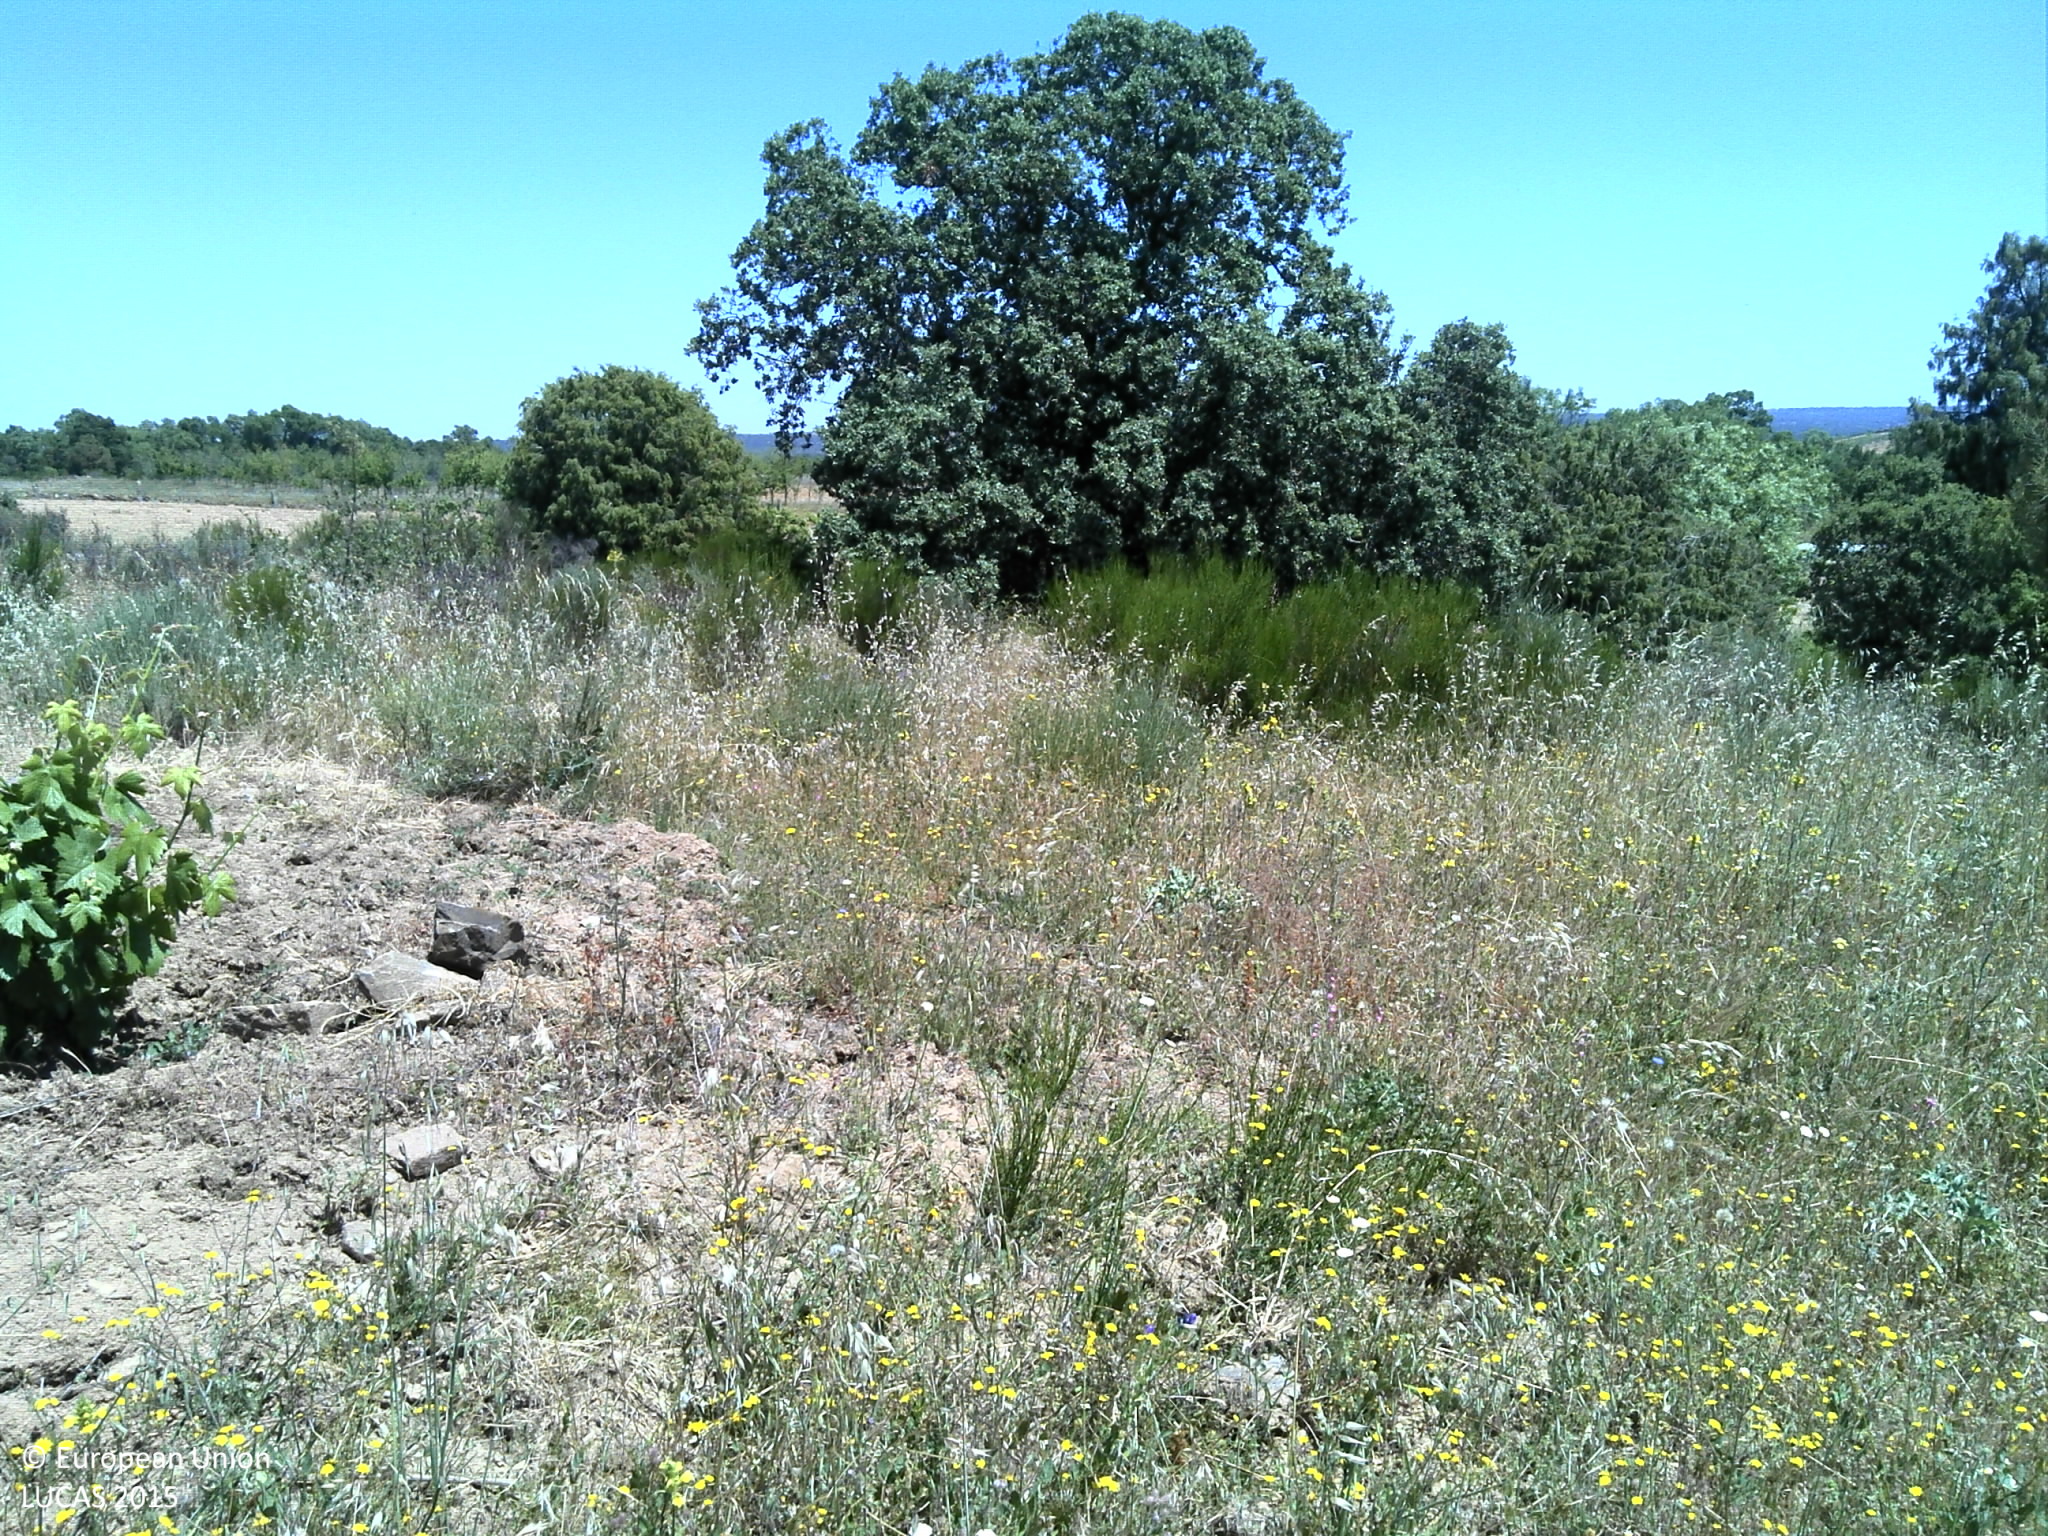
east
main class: Artificial land
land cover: Other artificial areas
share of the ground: 25 - 50 %
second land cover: Grassland without tree/shrub cover
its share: 50 - 75 %
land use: Electricity, gas and thermal power distribution
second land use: Agriculture (excluding fallow land and kitchen gardens)
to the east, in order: Grassland without tree/shrub cover; Electric lines; Grassland without tree/shrub cover; Grassland with sparse tree/shrub cover; Broadleaved woodland; Grassland with sparse tree/shrub cover; Fences; Dry stone walls; Other bare soil; Vineyards; Fences; Grass margins; Tracks; Grass margins; Spontaneously vegetated surfaces; Shruby margins; Abandoned hedges; Grassland without tree/shrub cover
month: May
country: PT
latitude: 41.4061
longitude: -6.3547
